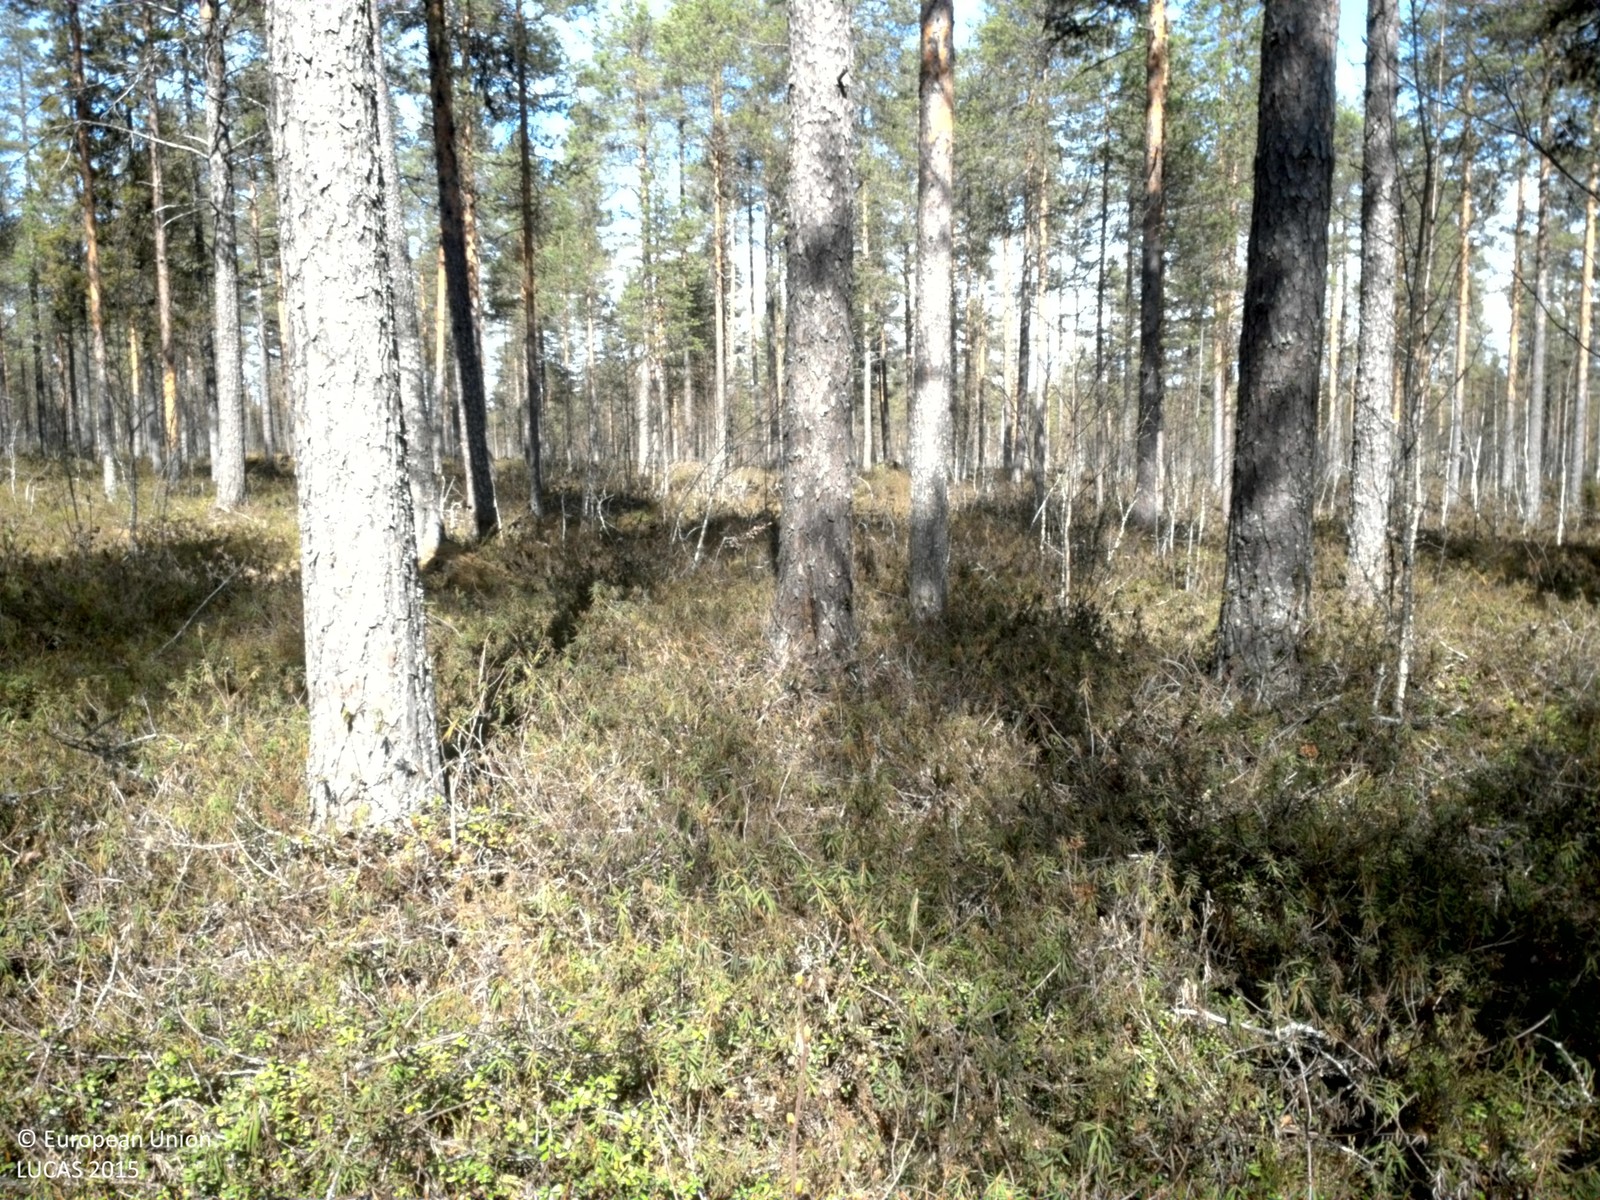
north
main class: Woodland
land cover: Pine dominated mixed woodland
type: boreal forest
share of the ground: 50 - 75 %
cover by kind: coniferous forest trees 45 %, shrubs 40 %, broadleaved forest trees 15 %
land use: Forestry
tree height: > 5 m
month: May
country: SE
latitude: 66.3005
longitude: 23.5207
